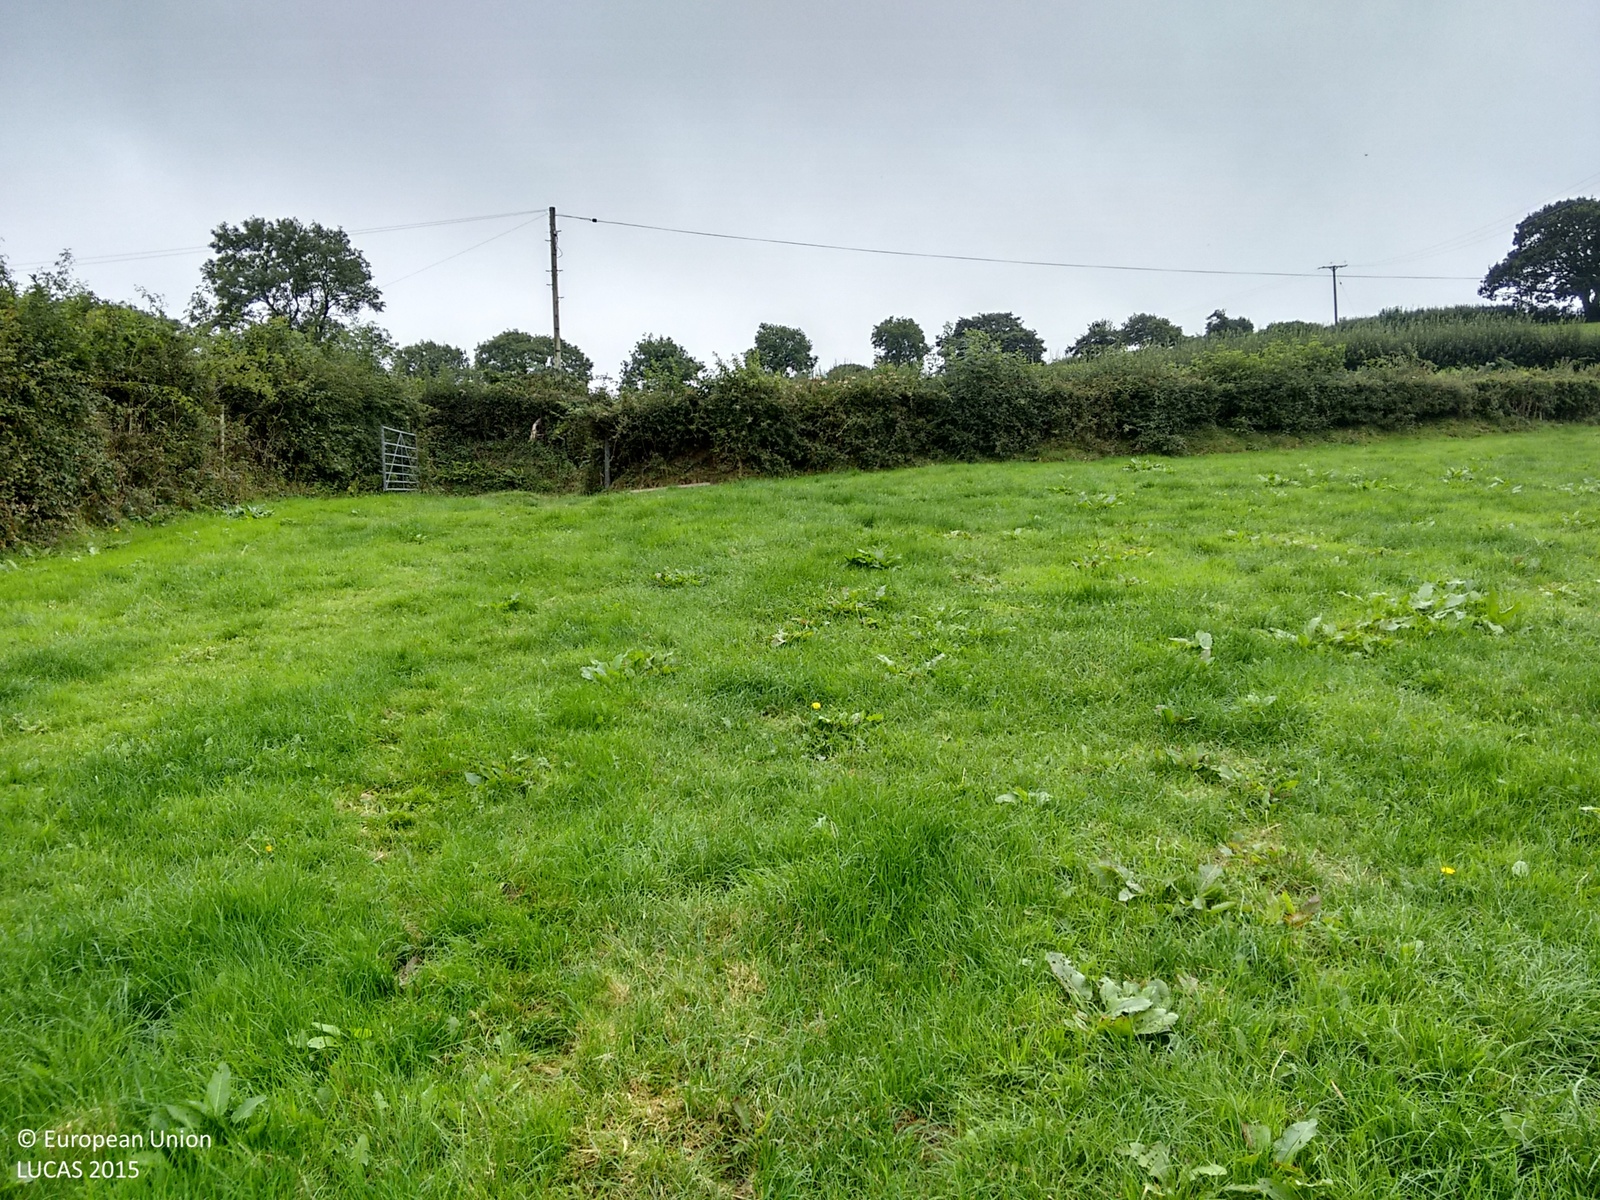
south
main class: Grassland
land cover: Grassland without tree/shrub cover
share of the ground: > 75 %
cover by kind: herbaceous plants 100 %
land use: Agriculture (excluding fallow land and kitchen gardens)
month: August
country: GB
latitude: 51.7098
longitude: -4.7128
